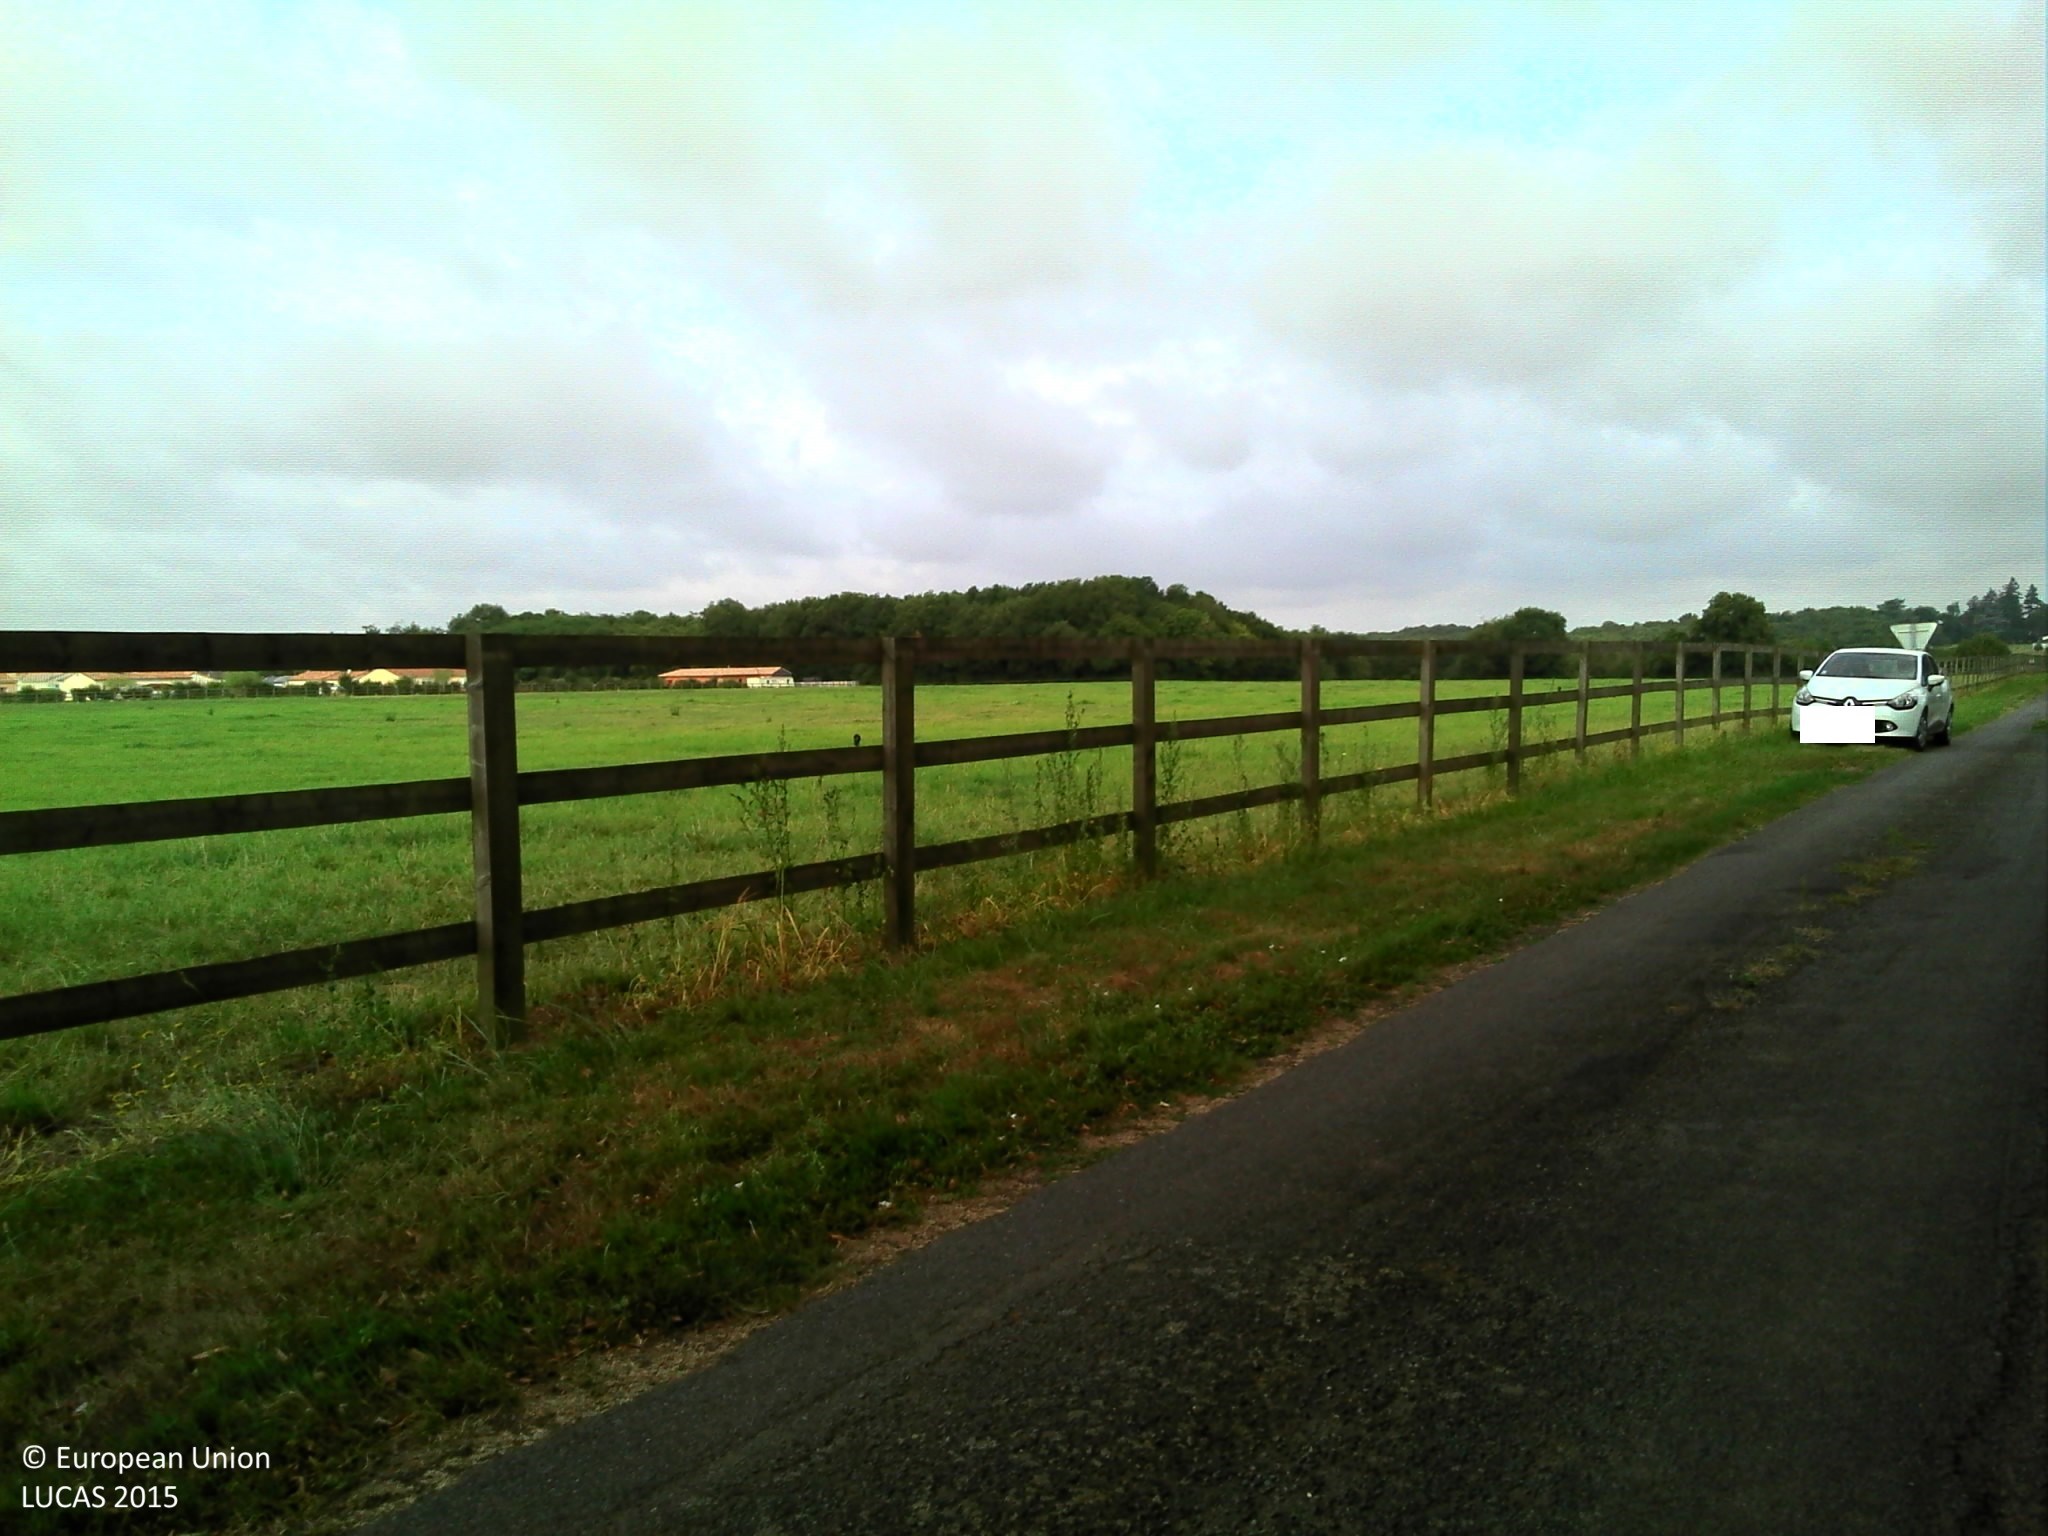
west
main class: Grassland
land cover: Grassland without tree/shrub cover
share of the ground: > 75 %
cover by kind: herbaceous plants 100 %
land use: Agriculture (excluding fallow land and kitchen gardens)
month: August
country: FR
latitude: 46.3020
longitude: 0.2308
